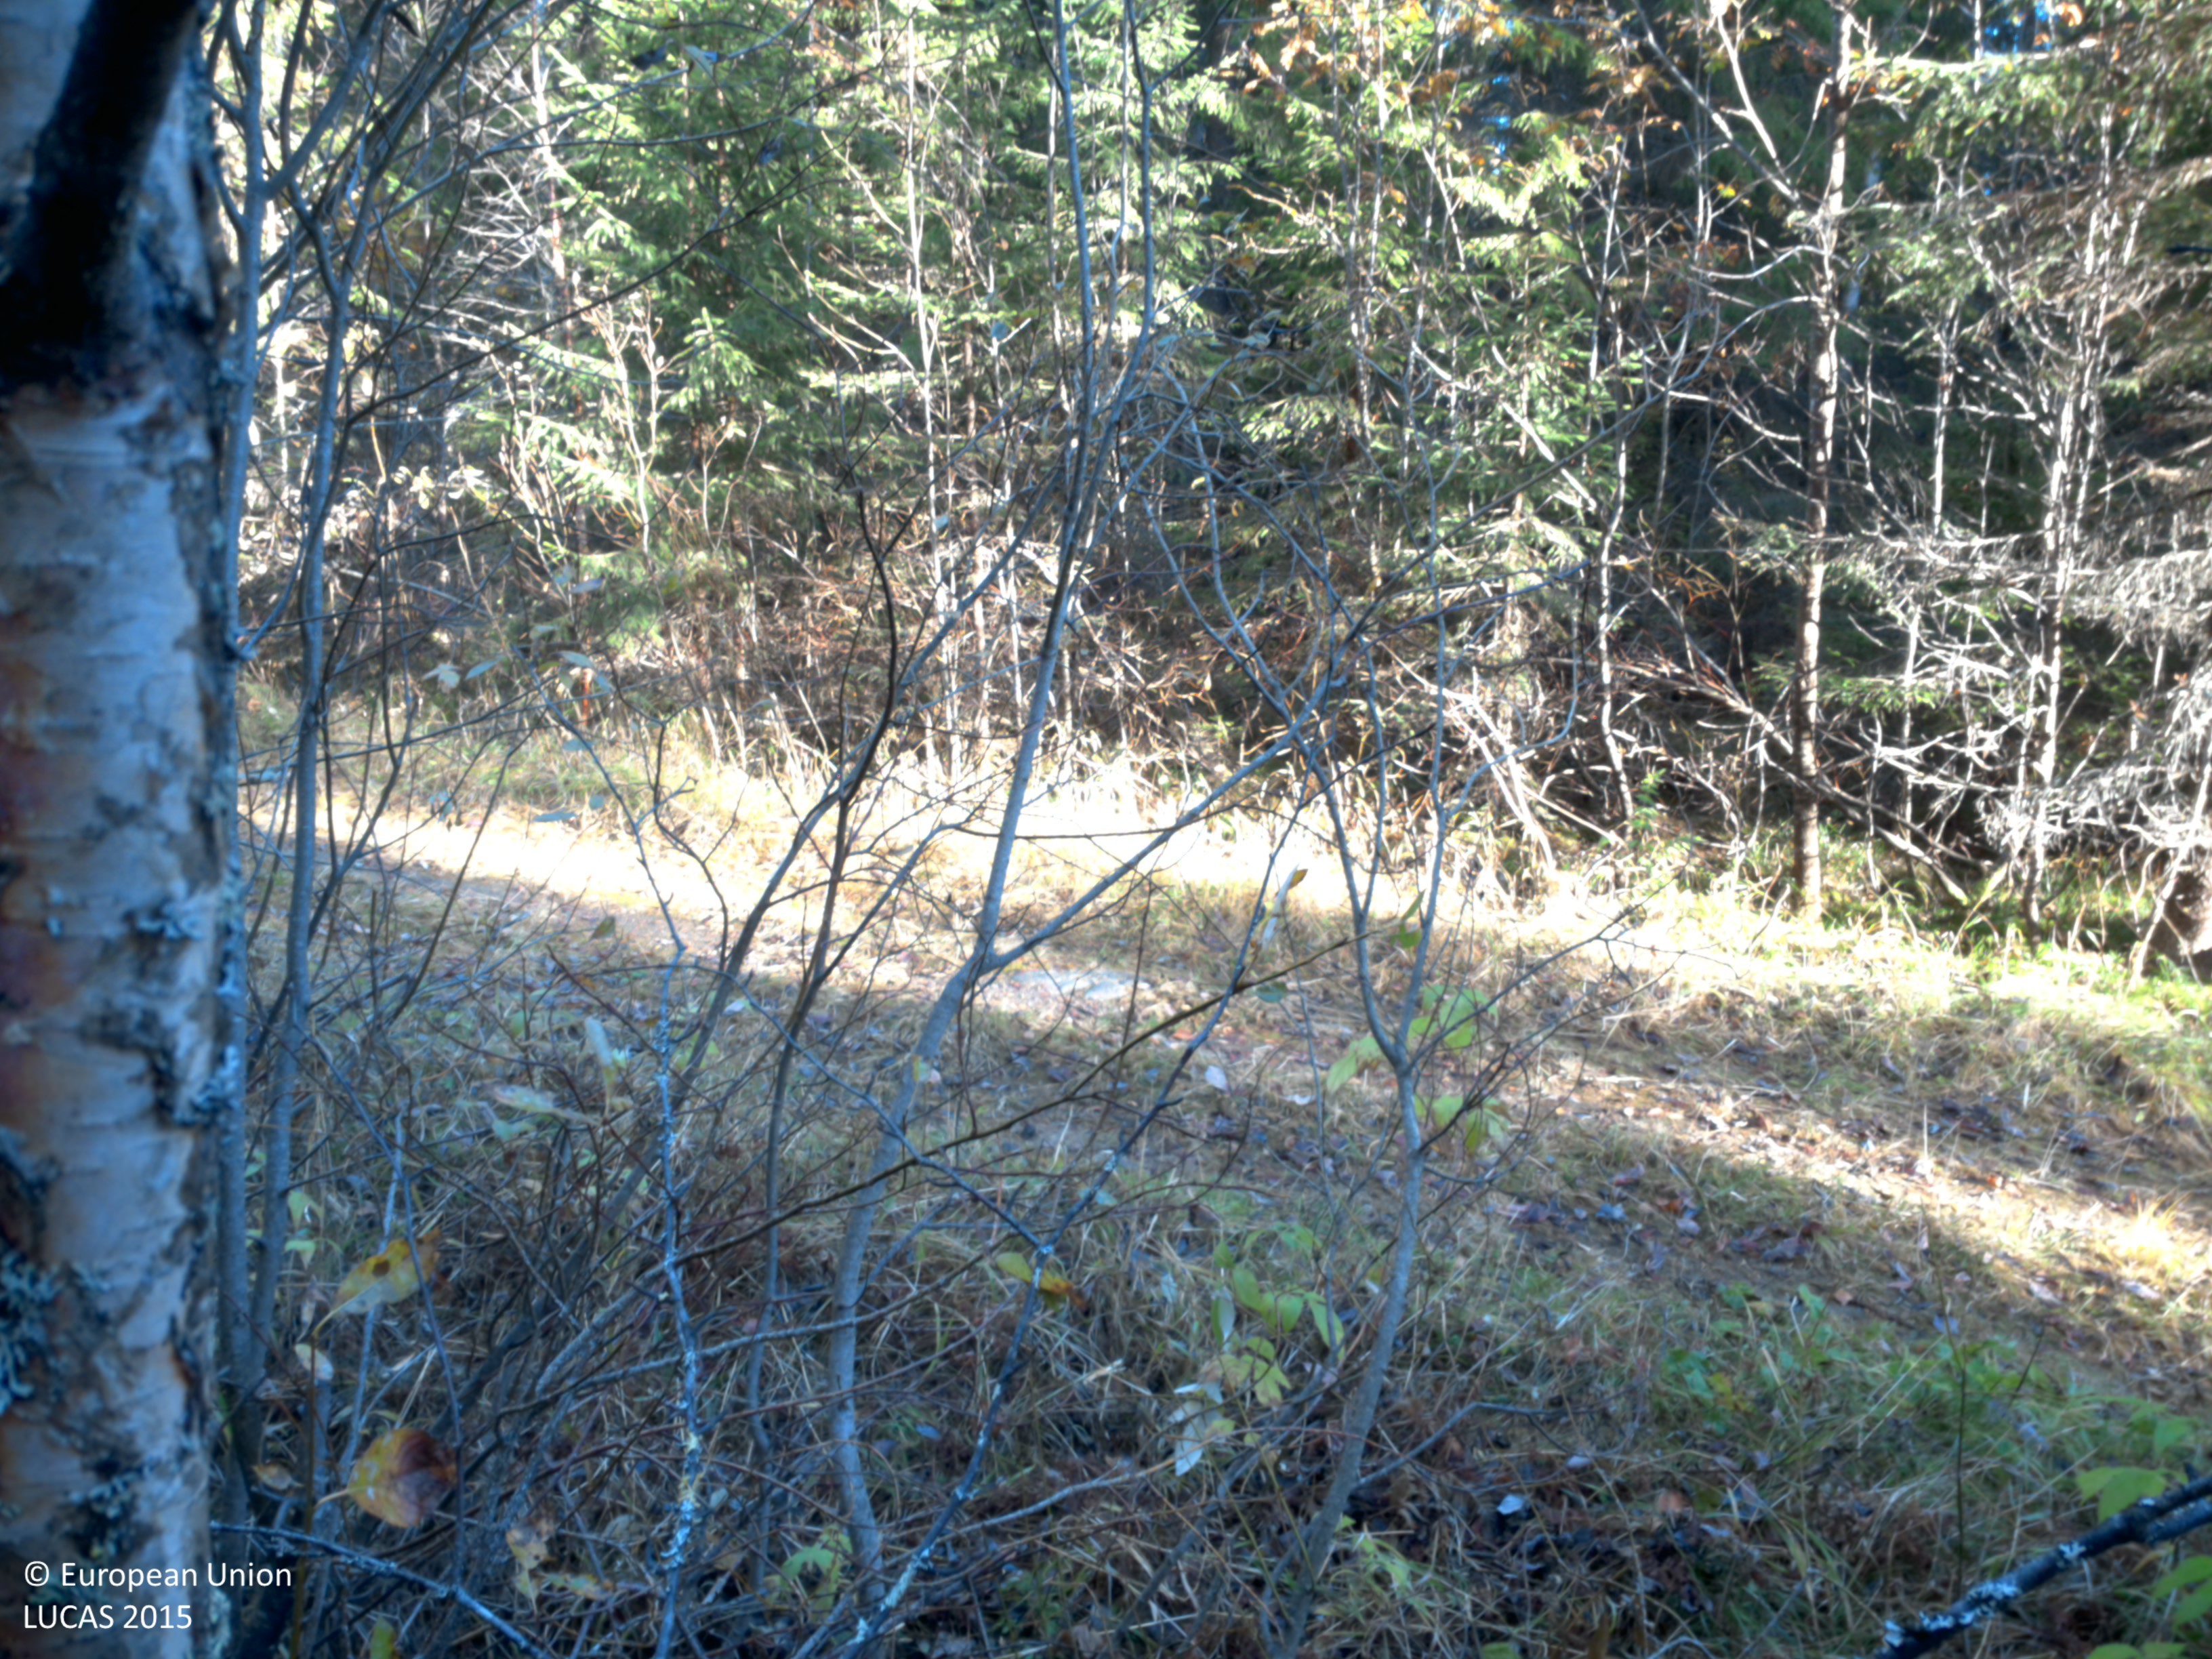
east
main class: Woodland
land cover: Other coniferous woodland
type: boreal forest
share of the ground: > 75 %
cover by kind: coniferous forest trees 80 %, shrubs 10 %, herbaceous plants 5 %, lichens and mosses 5 %
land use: Forestry
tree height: > 5 m
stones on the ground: 25 - 50 %
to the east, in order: Other coniferous woodland; Rivers and streams; Tracks; Spruce dominated mixed woodland; Other coniferous woodland; Spruce dominated mixed woodland; Grassland without tree/shrub cover; Paved roads, cycling and walking lanes; Ditches and canals; Spruce dominated mixed woodland; Spruce dominated coniferous woodland; Spontaneously vegetated surfaces; Broadleaved woodland
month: October
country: SE
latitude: 63.8747
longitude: 18.5835
